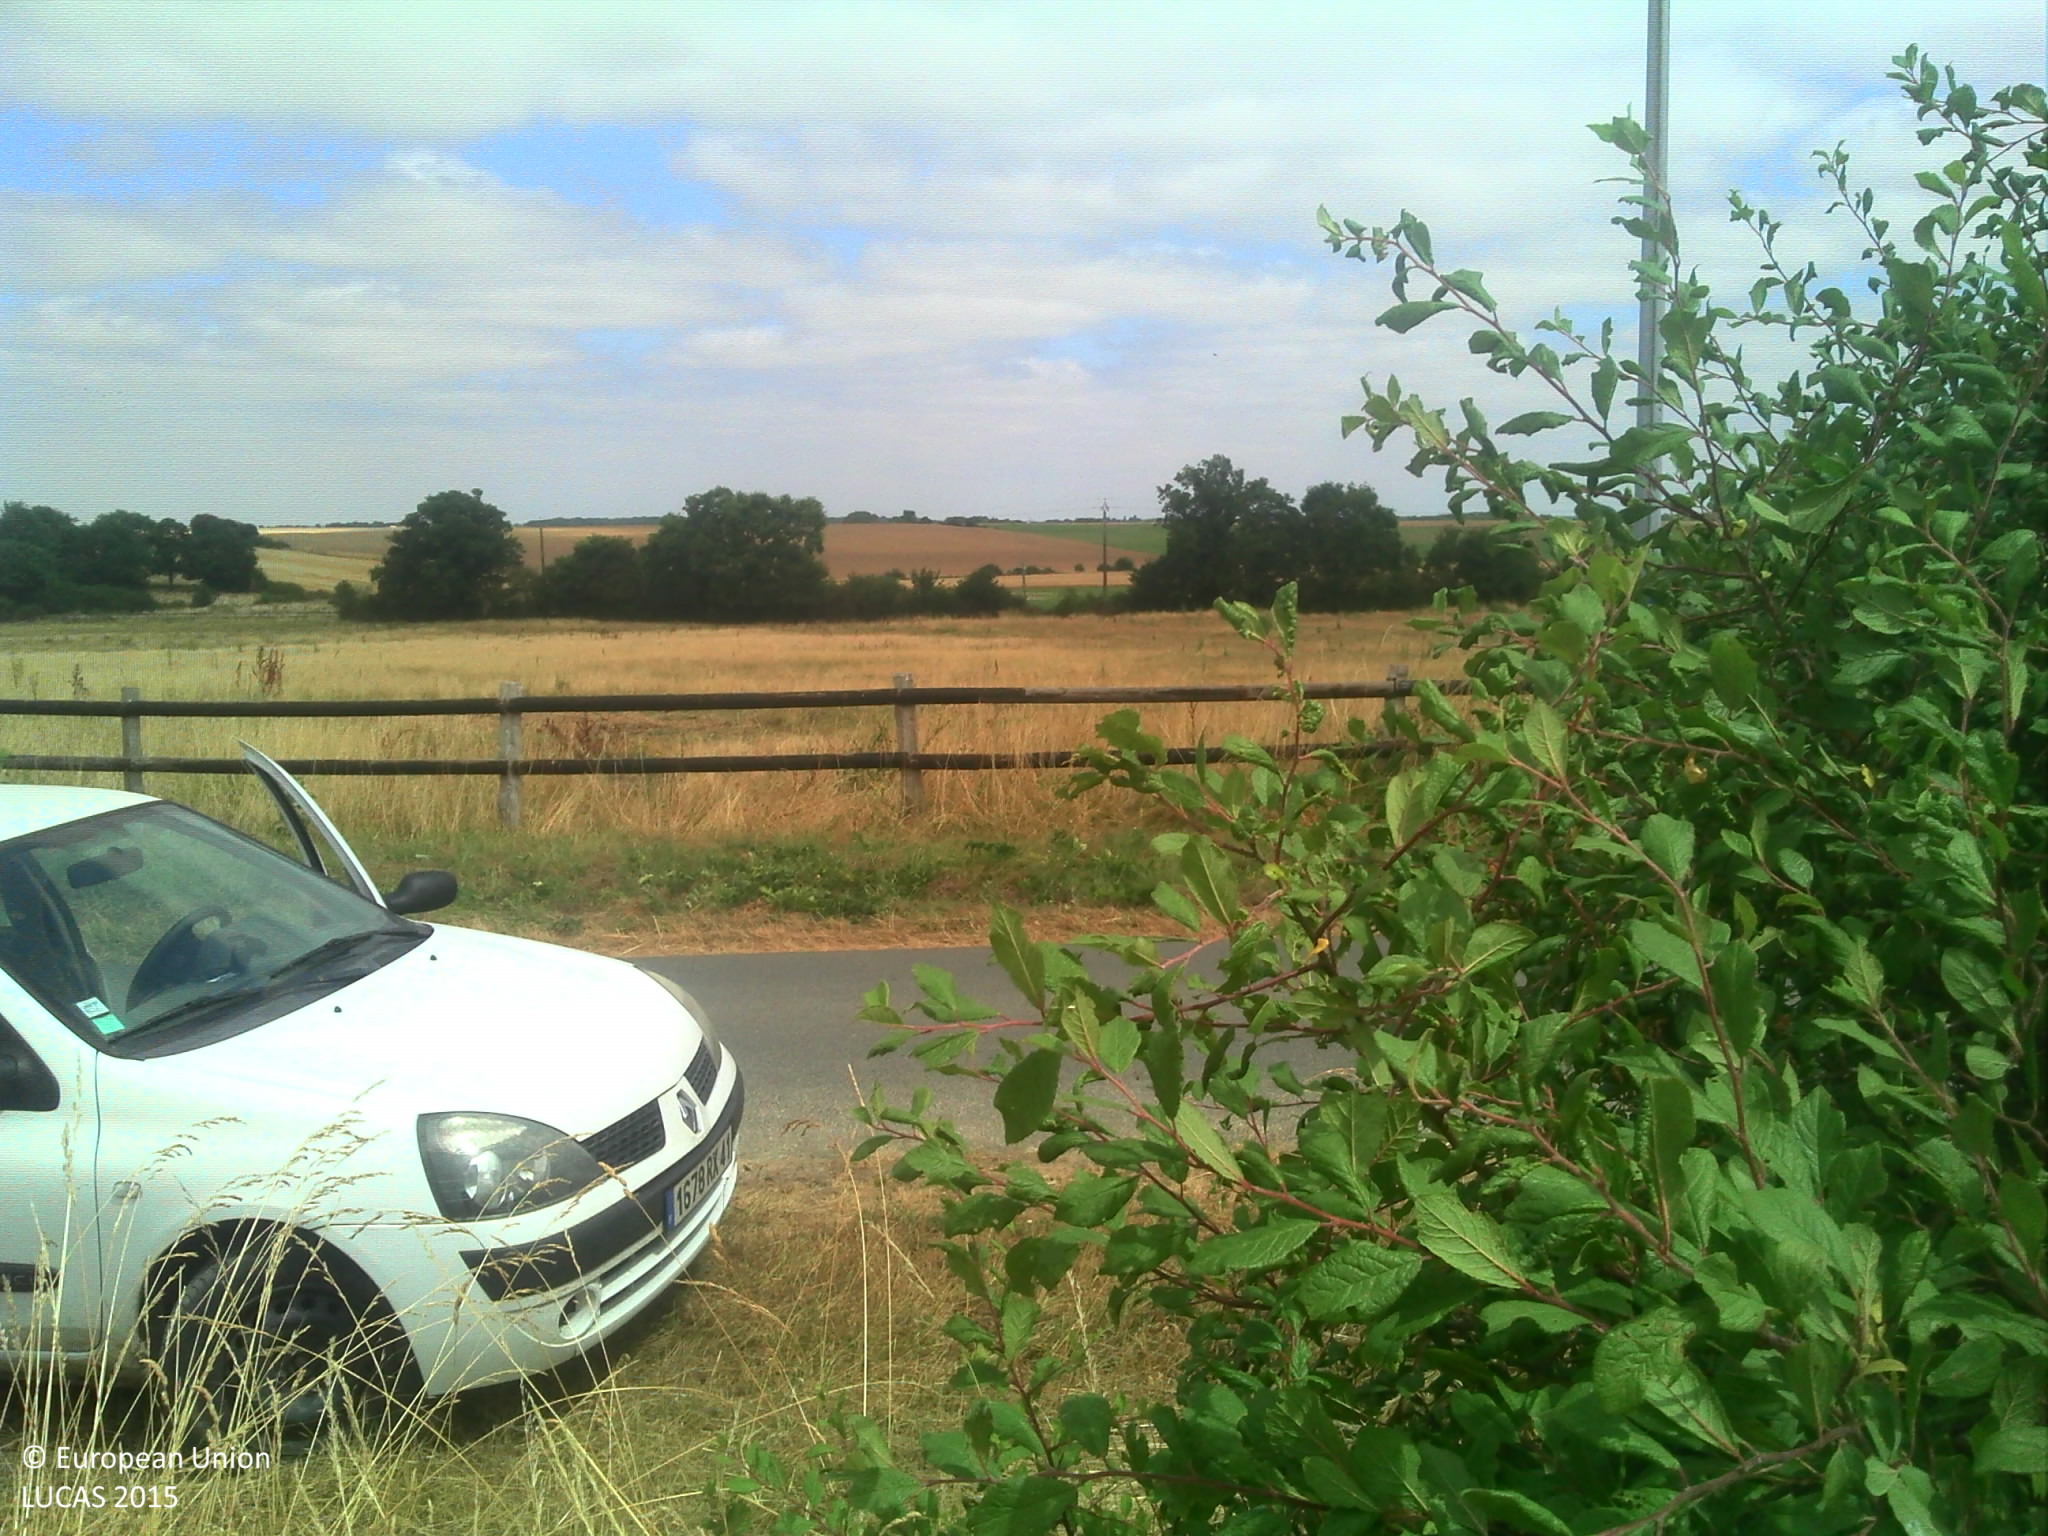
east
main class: Cropland
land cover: Common wheat
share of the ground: > 75 %
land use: Agriculture (excluding fallow land and kitchen gardens)
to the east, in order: Common wheat; Managed hedges; Grass margins; Tracks; Grass margins; Fences; Grassland without tree/shrub cover; Fences; Conifer hedges
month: July
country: FR
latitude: 47.8850
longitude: 0.9271
